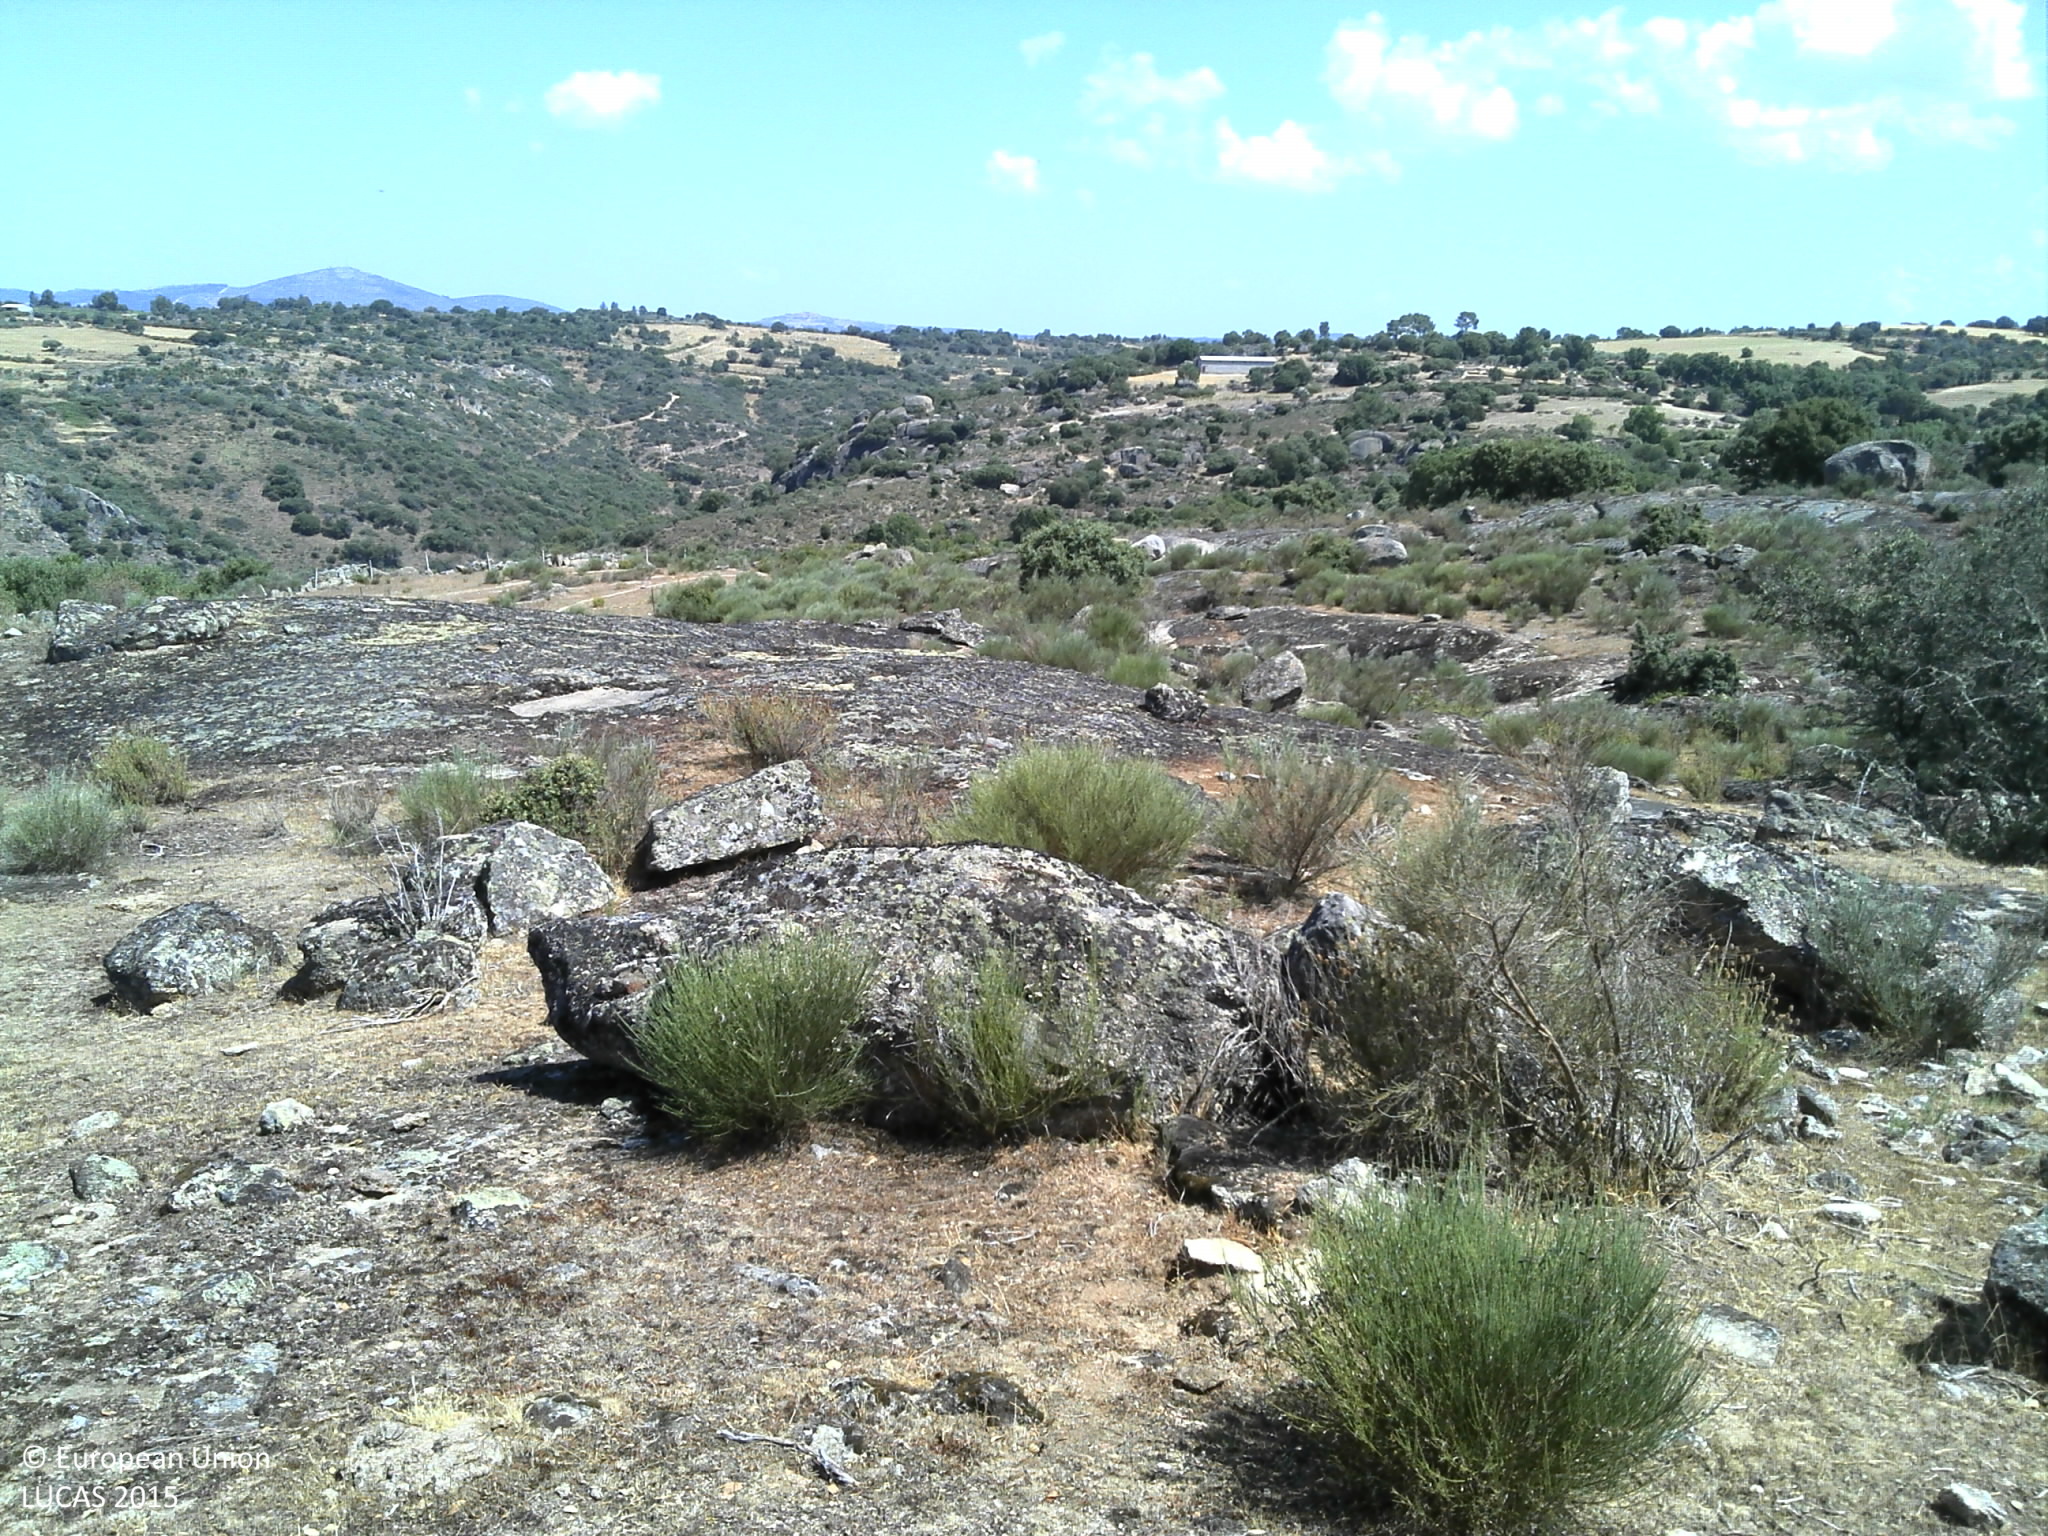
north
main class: Grassland
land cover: Grassland with sparse tree/shrub cover
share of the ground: 25 - 50 %
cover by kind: consolidated bare surface 45 %, herbaceous plants 40 %, shrubs 10 %, broadleaved forest trees 5 %
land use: Agriculture (excluding fallow land and kitchen gardens)
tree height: > 5 m
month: June
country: PT
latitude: 40.7692
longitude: -6.9609
